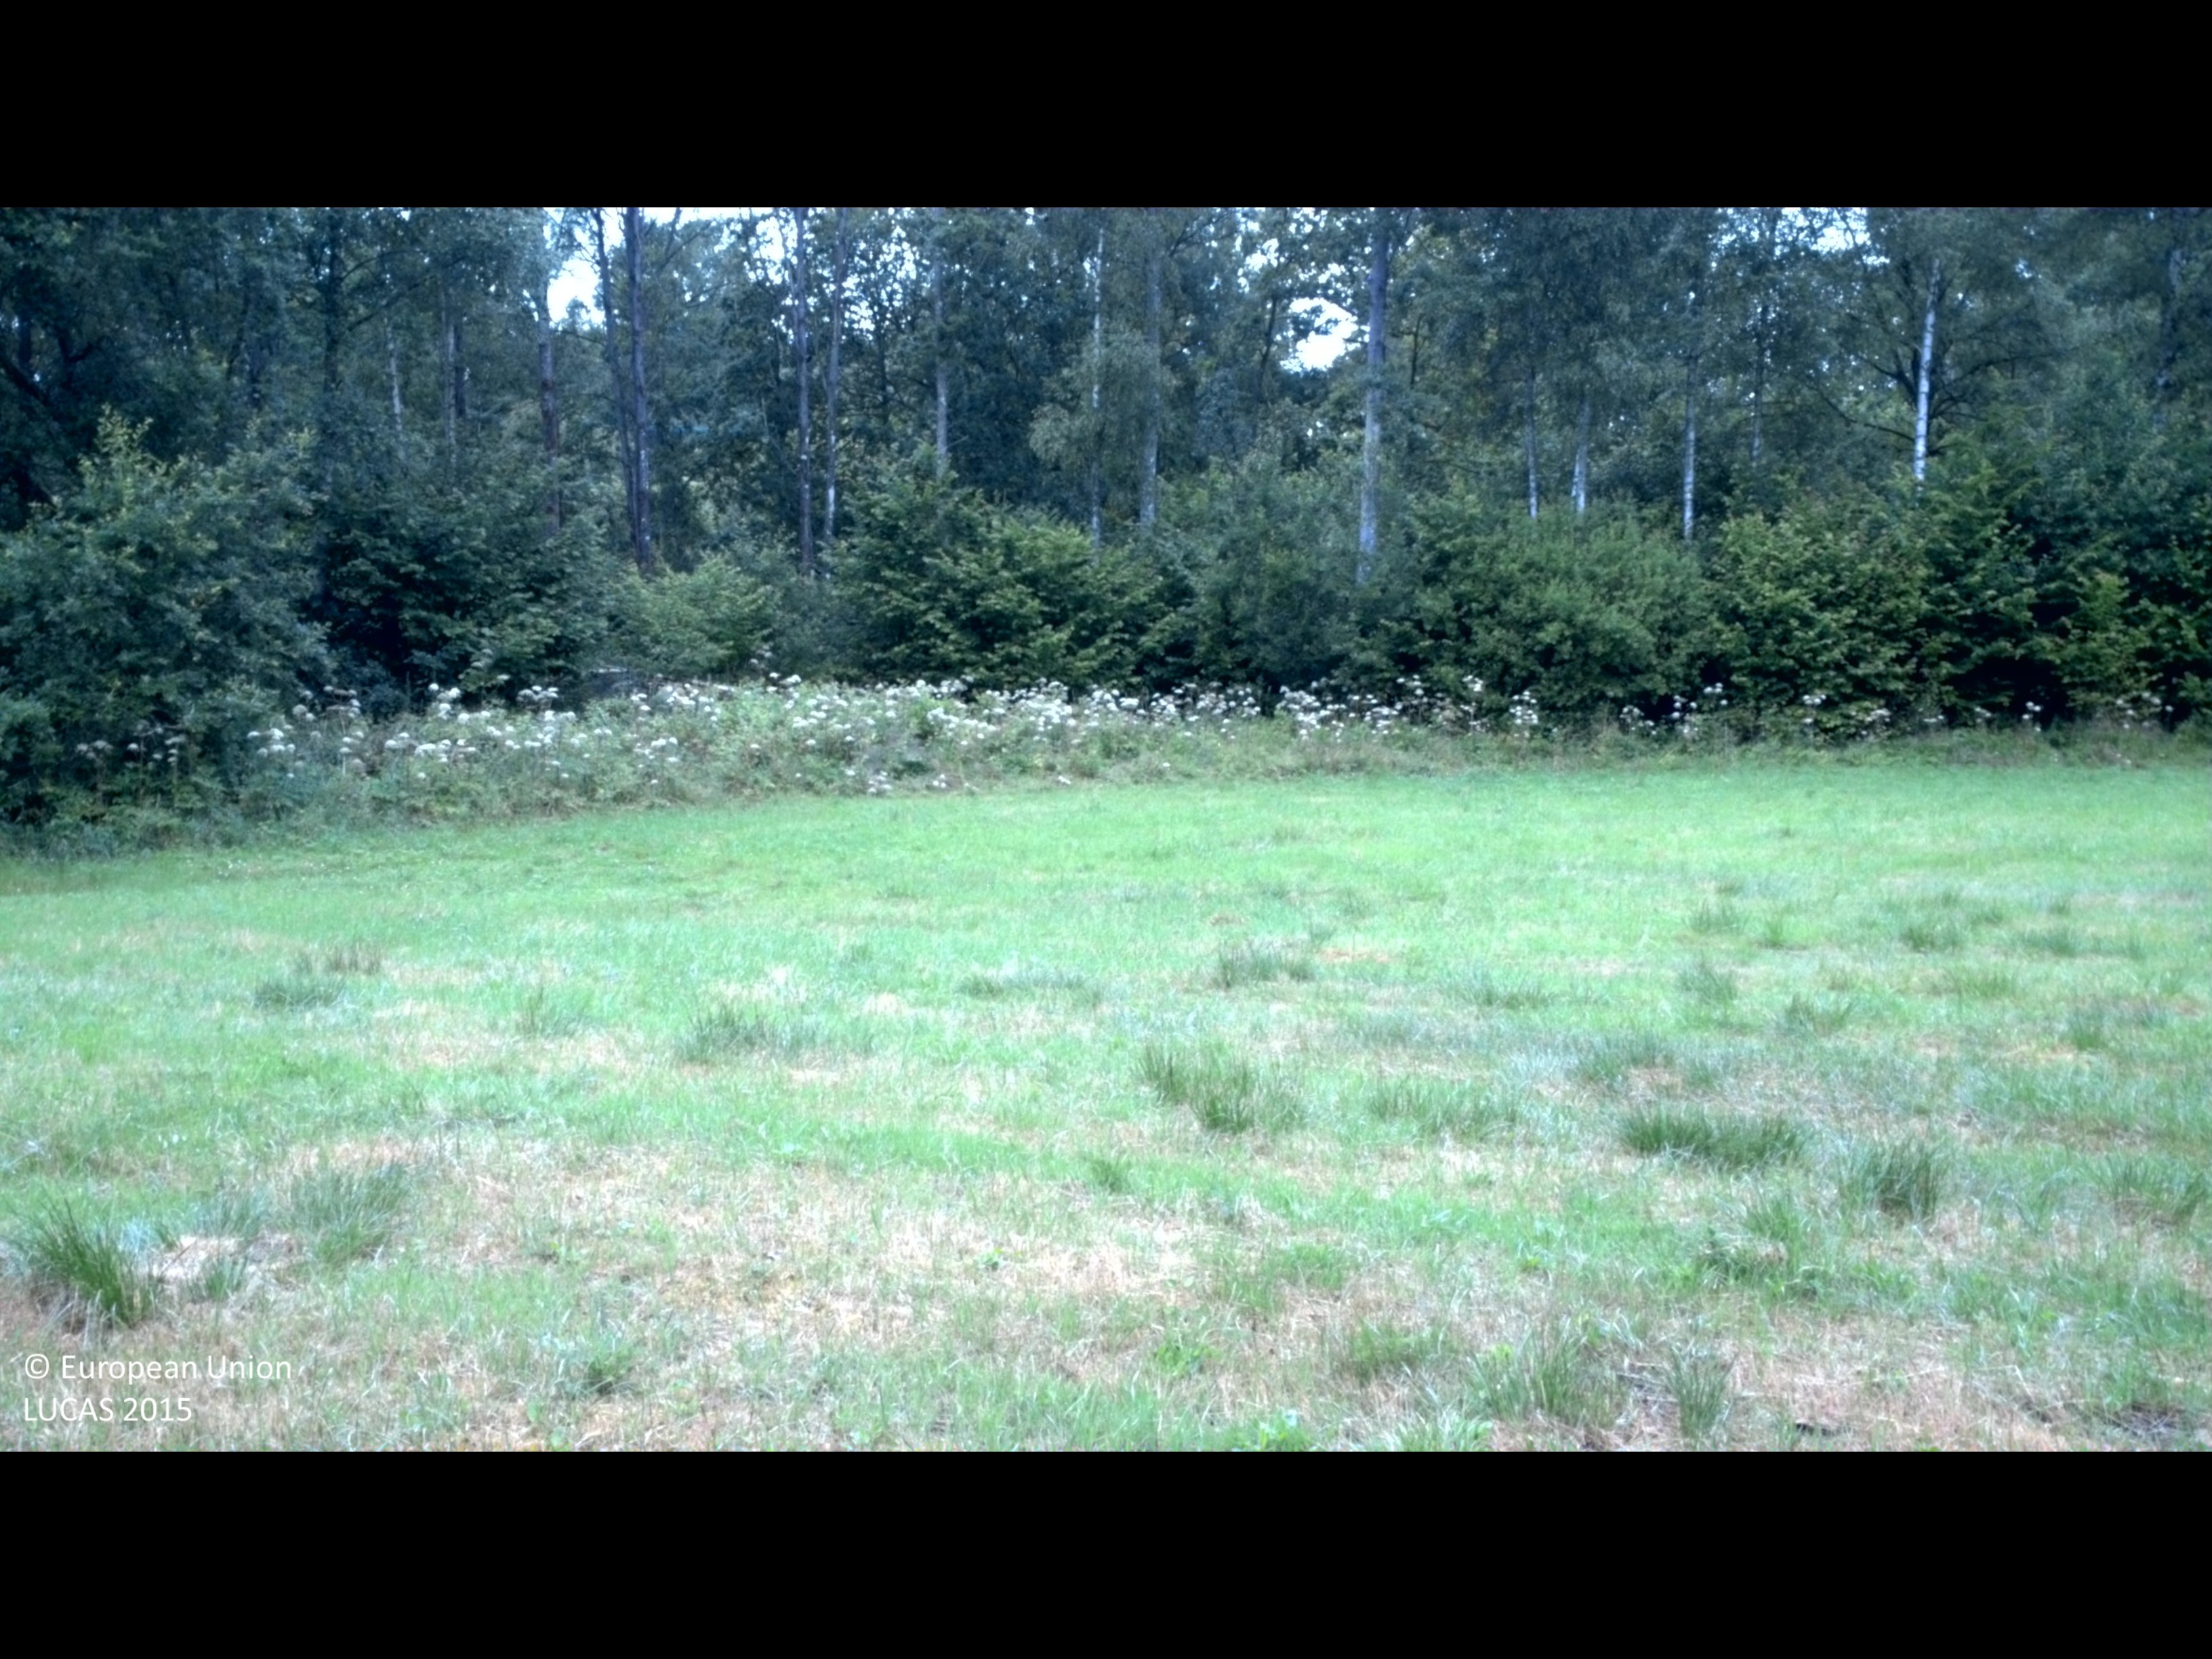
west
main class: Grassland
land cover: Grassland without tree/shrub cover
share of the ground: 50 - 75 %
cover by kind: herbaceous plants 60 %, lichens and mosses 40 %
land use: Agriculture (excluding fallow land and kitchen gardens)
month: July
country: SE
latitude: 56.4843
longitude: 14.0406
